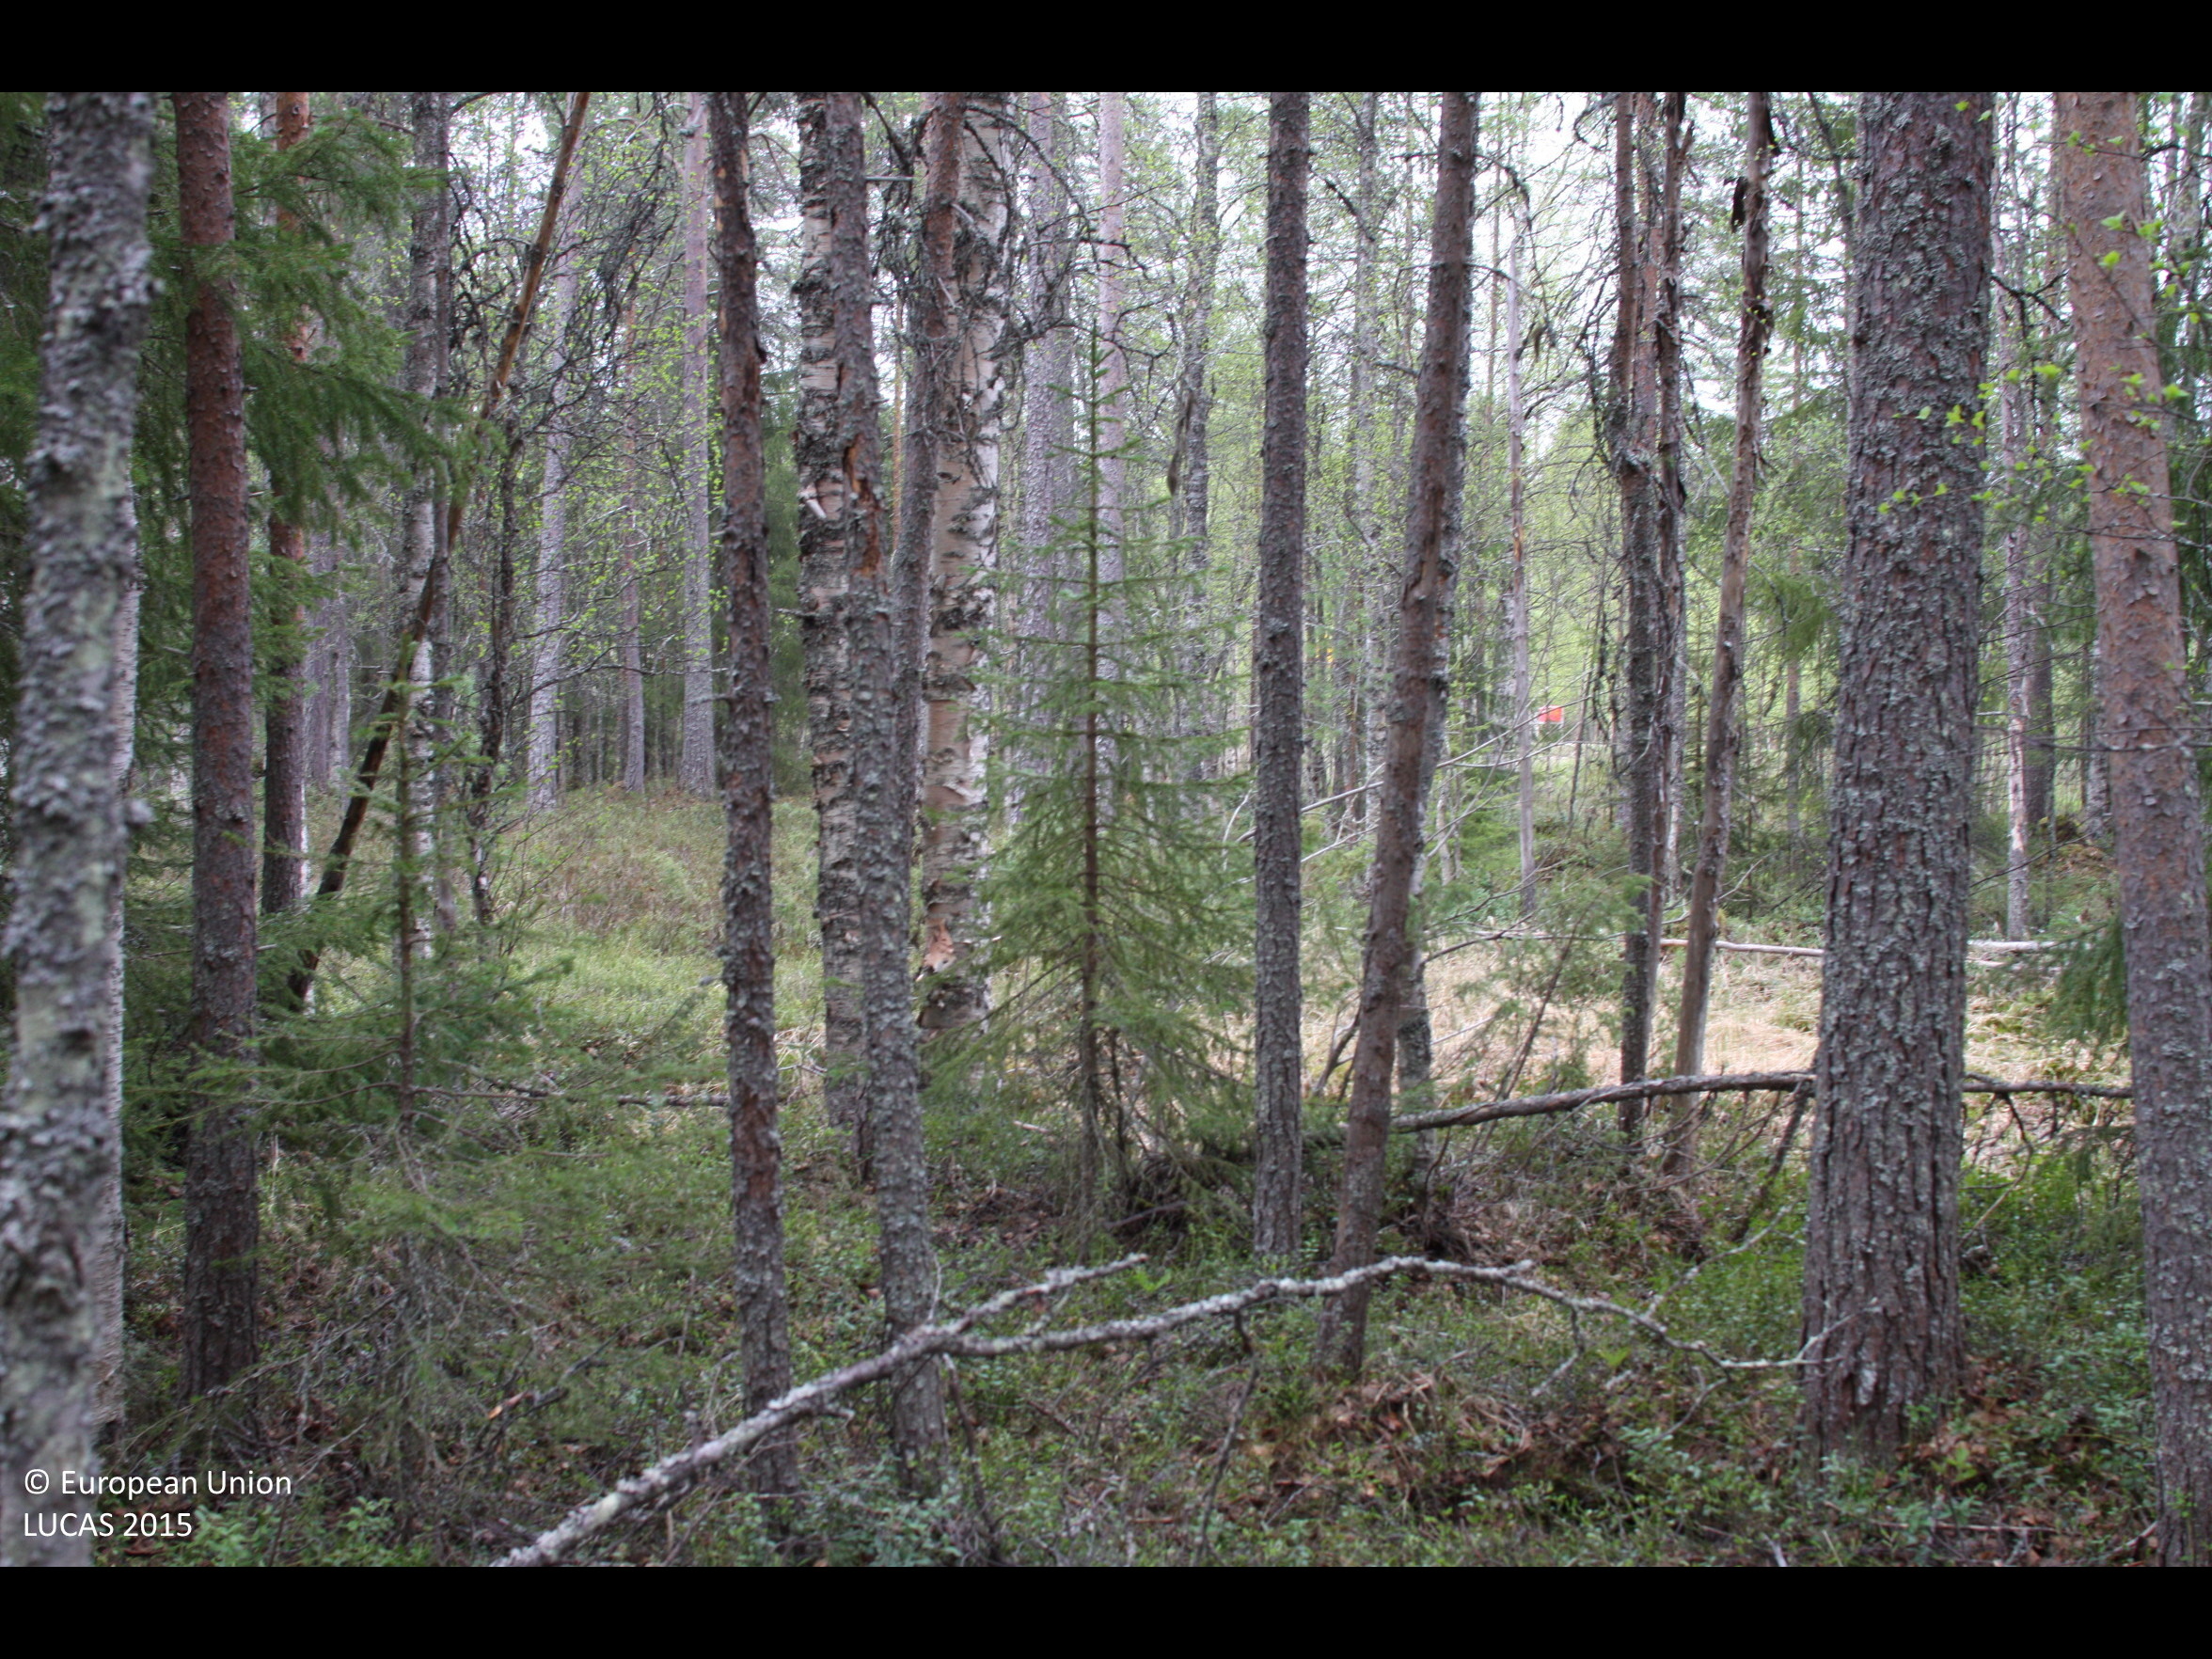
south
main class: Woodland
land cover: Pine dominated mixed woodland
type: boreal forest
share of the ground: > 75 %
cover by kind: coniferous forest trees 45 %, broadleaved forest trees 40 %, shrubs 10 %, herbaceous plants 5 %
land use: Forestry
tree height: > 5 m
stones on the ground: < 10 %
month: May
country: FI
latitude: 66.0877
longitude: 28.4346
